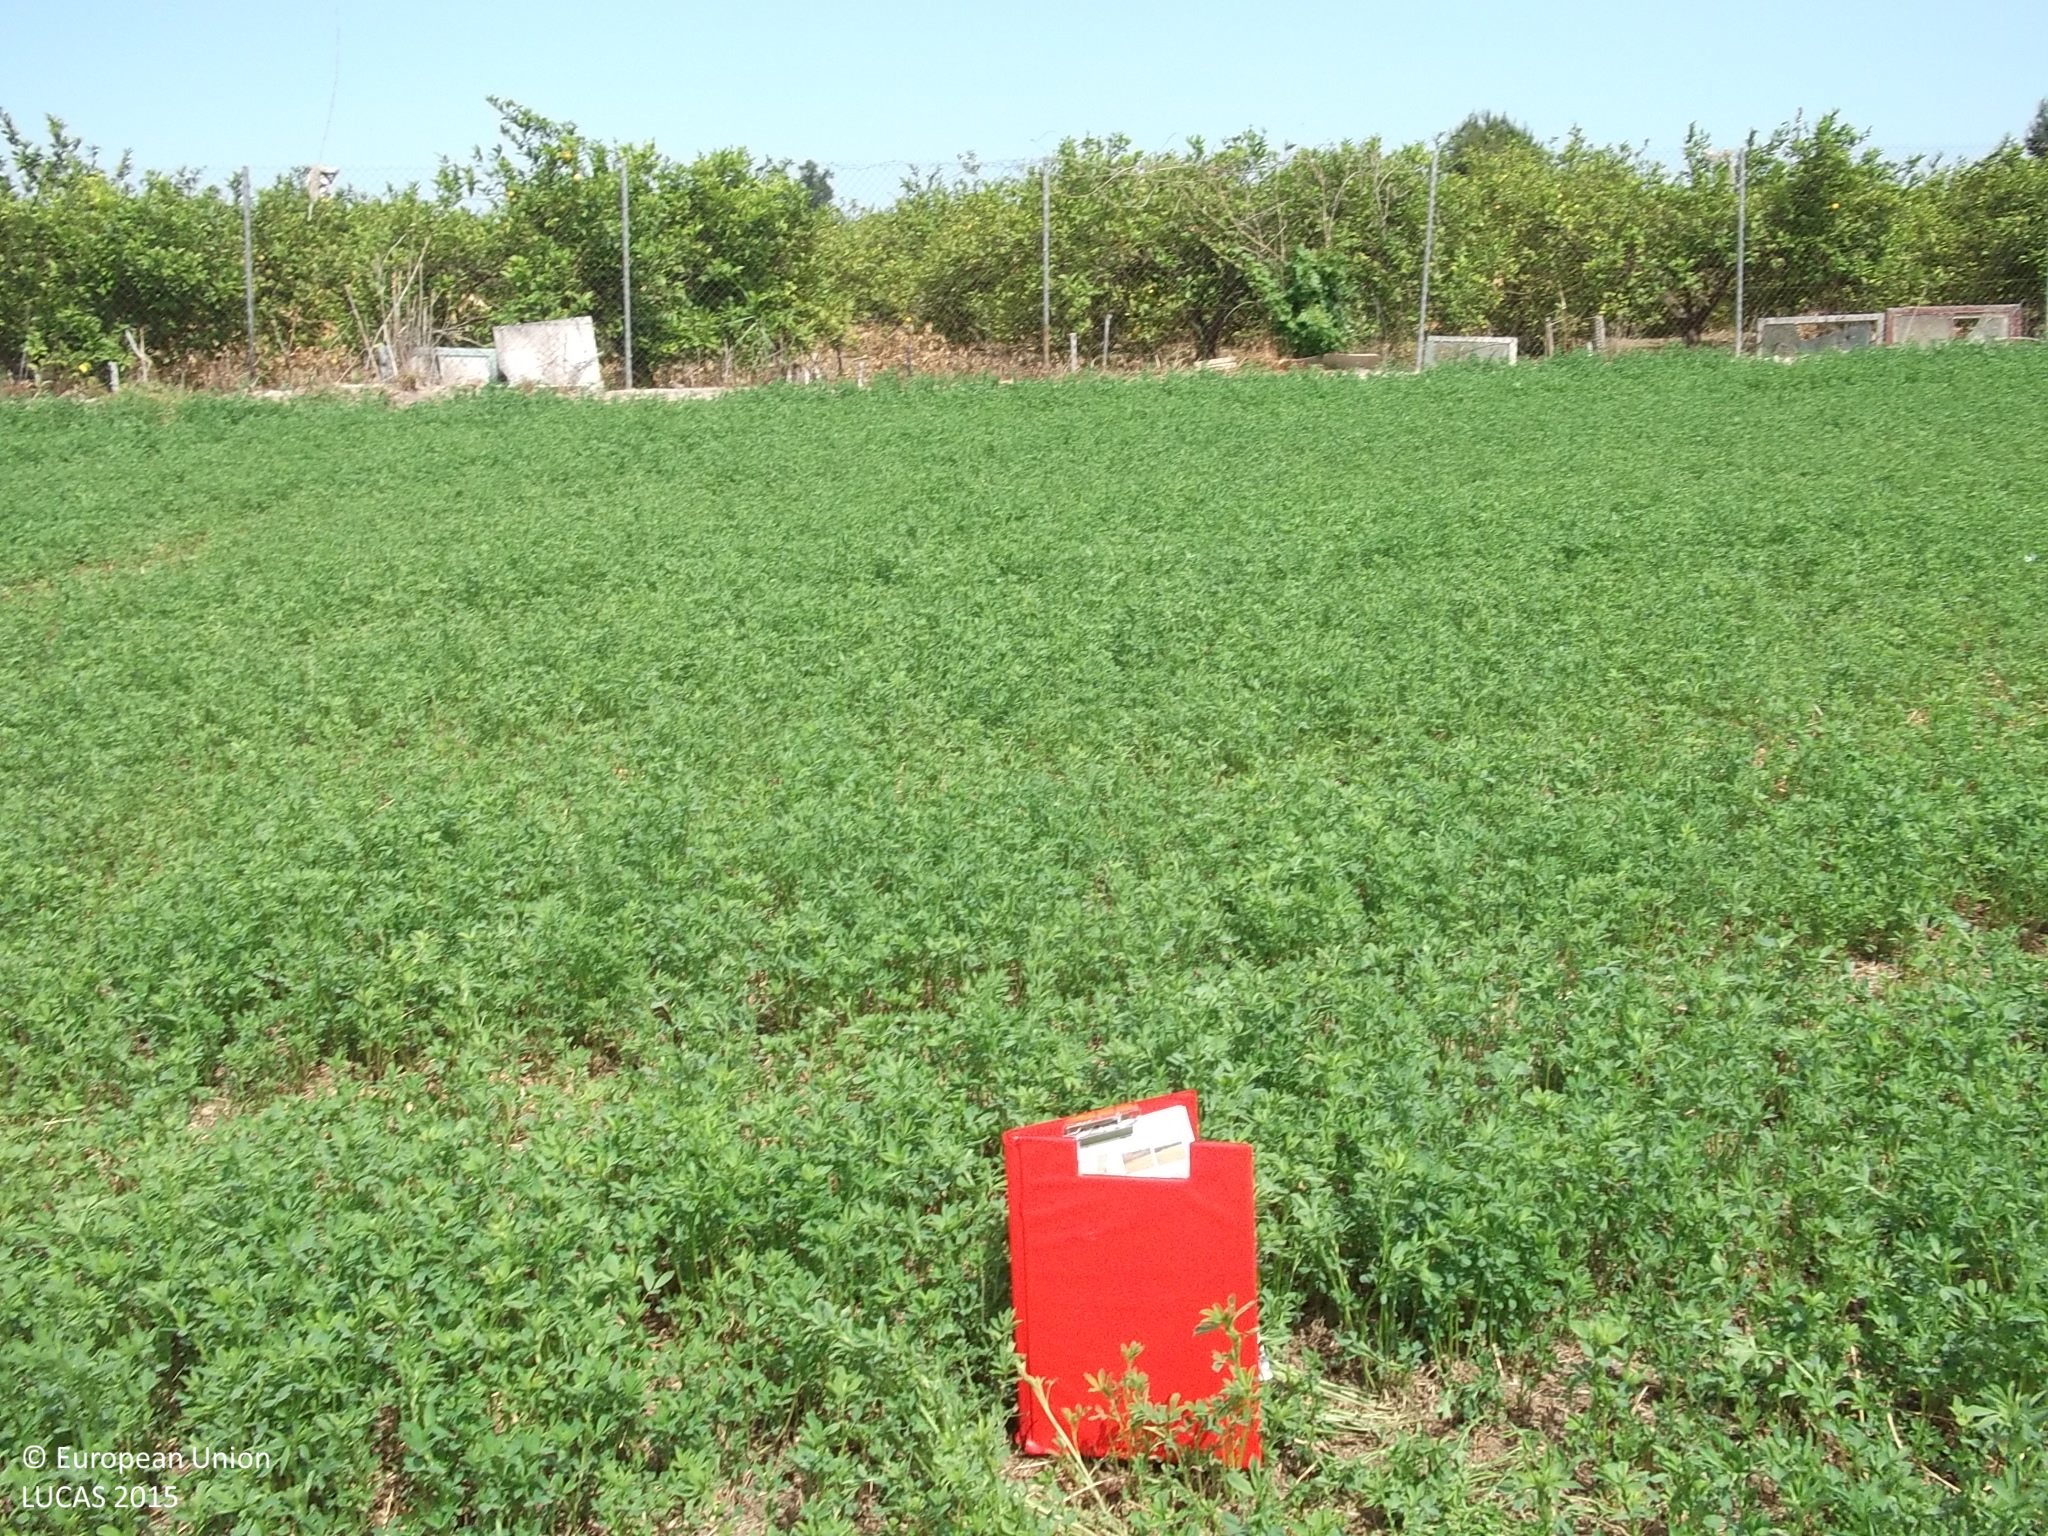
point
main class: Cropland
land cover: Lucerne
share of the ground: > 75 %
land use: Agriculture (excluding fallow land and kitchen gardens)
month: May
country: ES
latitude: 38.1115
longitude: -0.8534
